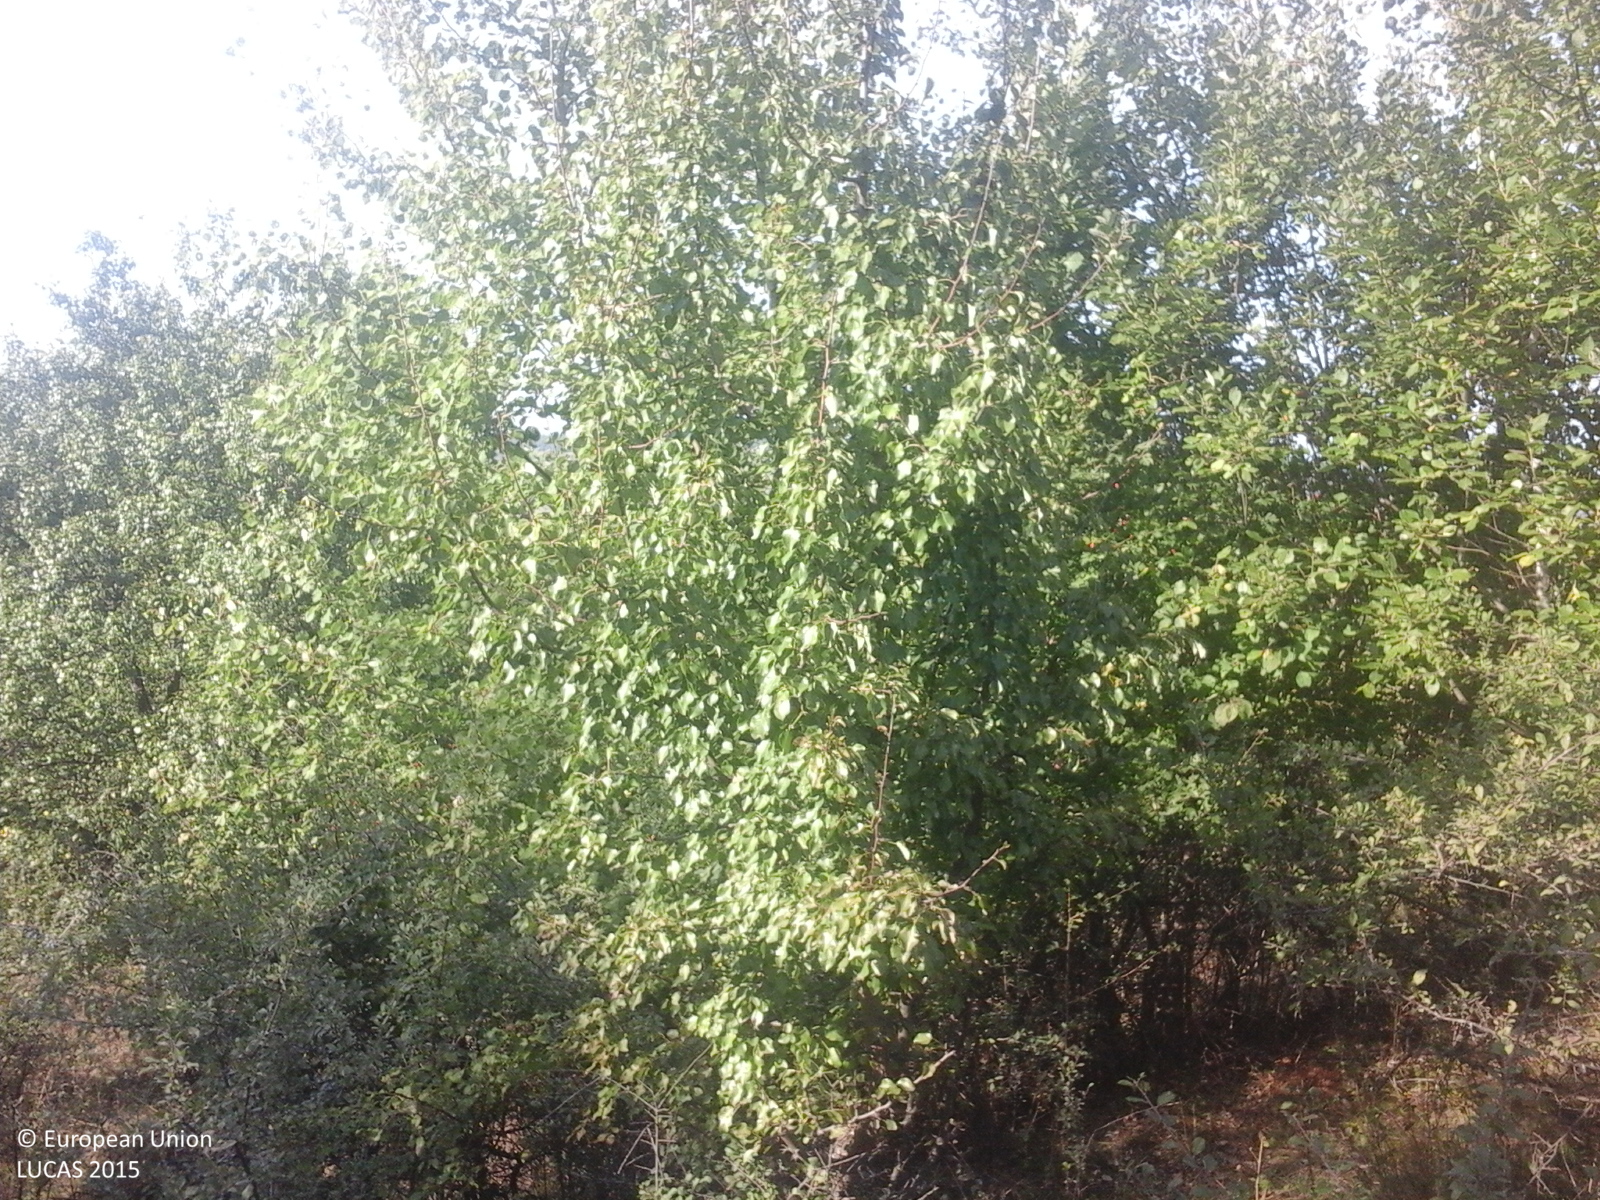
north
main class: Cropland
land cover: Apple fruit
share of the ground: > 75 %
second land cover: Grassland without tree/shrub cover
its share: > 75 %
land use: Agriculture (excluding fallow land and kitchen gardens)
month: September
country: RO
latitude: 46.7998
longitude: 23.3928
